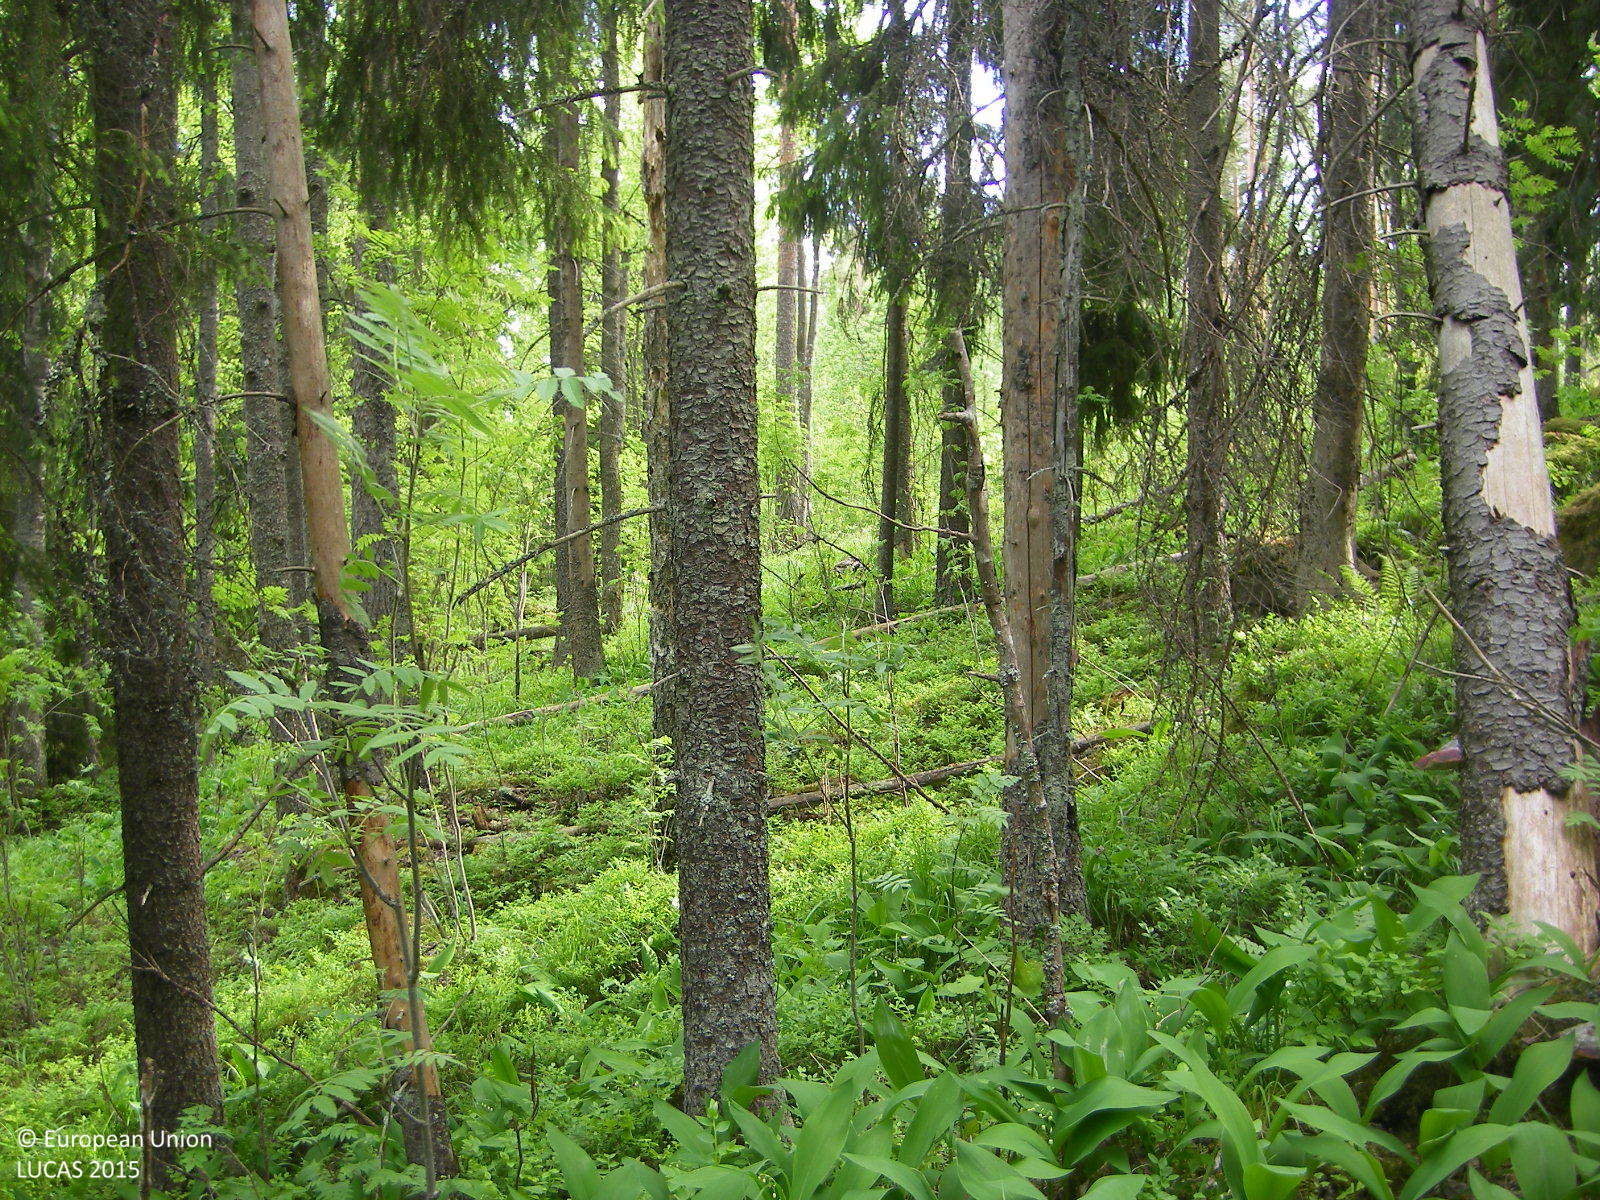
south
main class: Woodland
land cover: Spruce dominated mixed woodland
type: boreal forest
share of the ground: 50 - 75 %
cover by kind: broadleaved forest trees 40 %, coniferous forest trees 30 %, shrubs 15 %, herbaceous plants 10 %, lichens and mosses 5 %
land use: Forestry
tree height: > 5 m
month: June
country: FI
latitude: 60.3514
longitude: 24.7746
